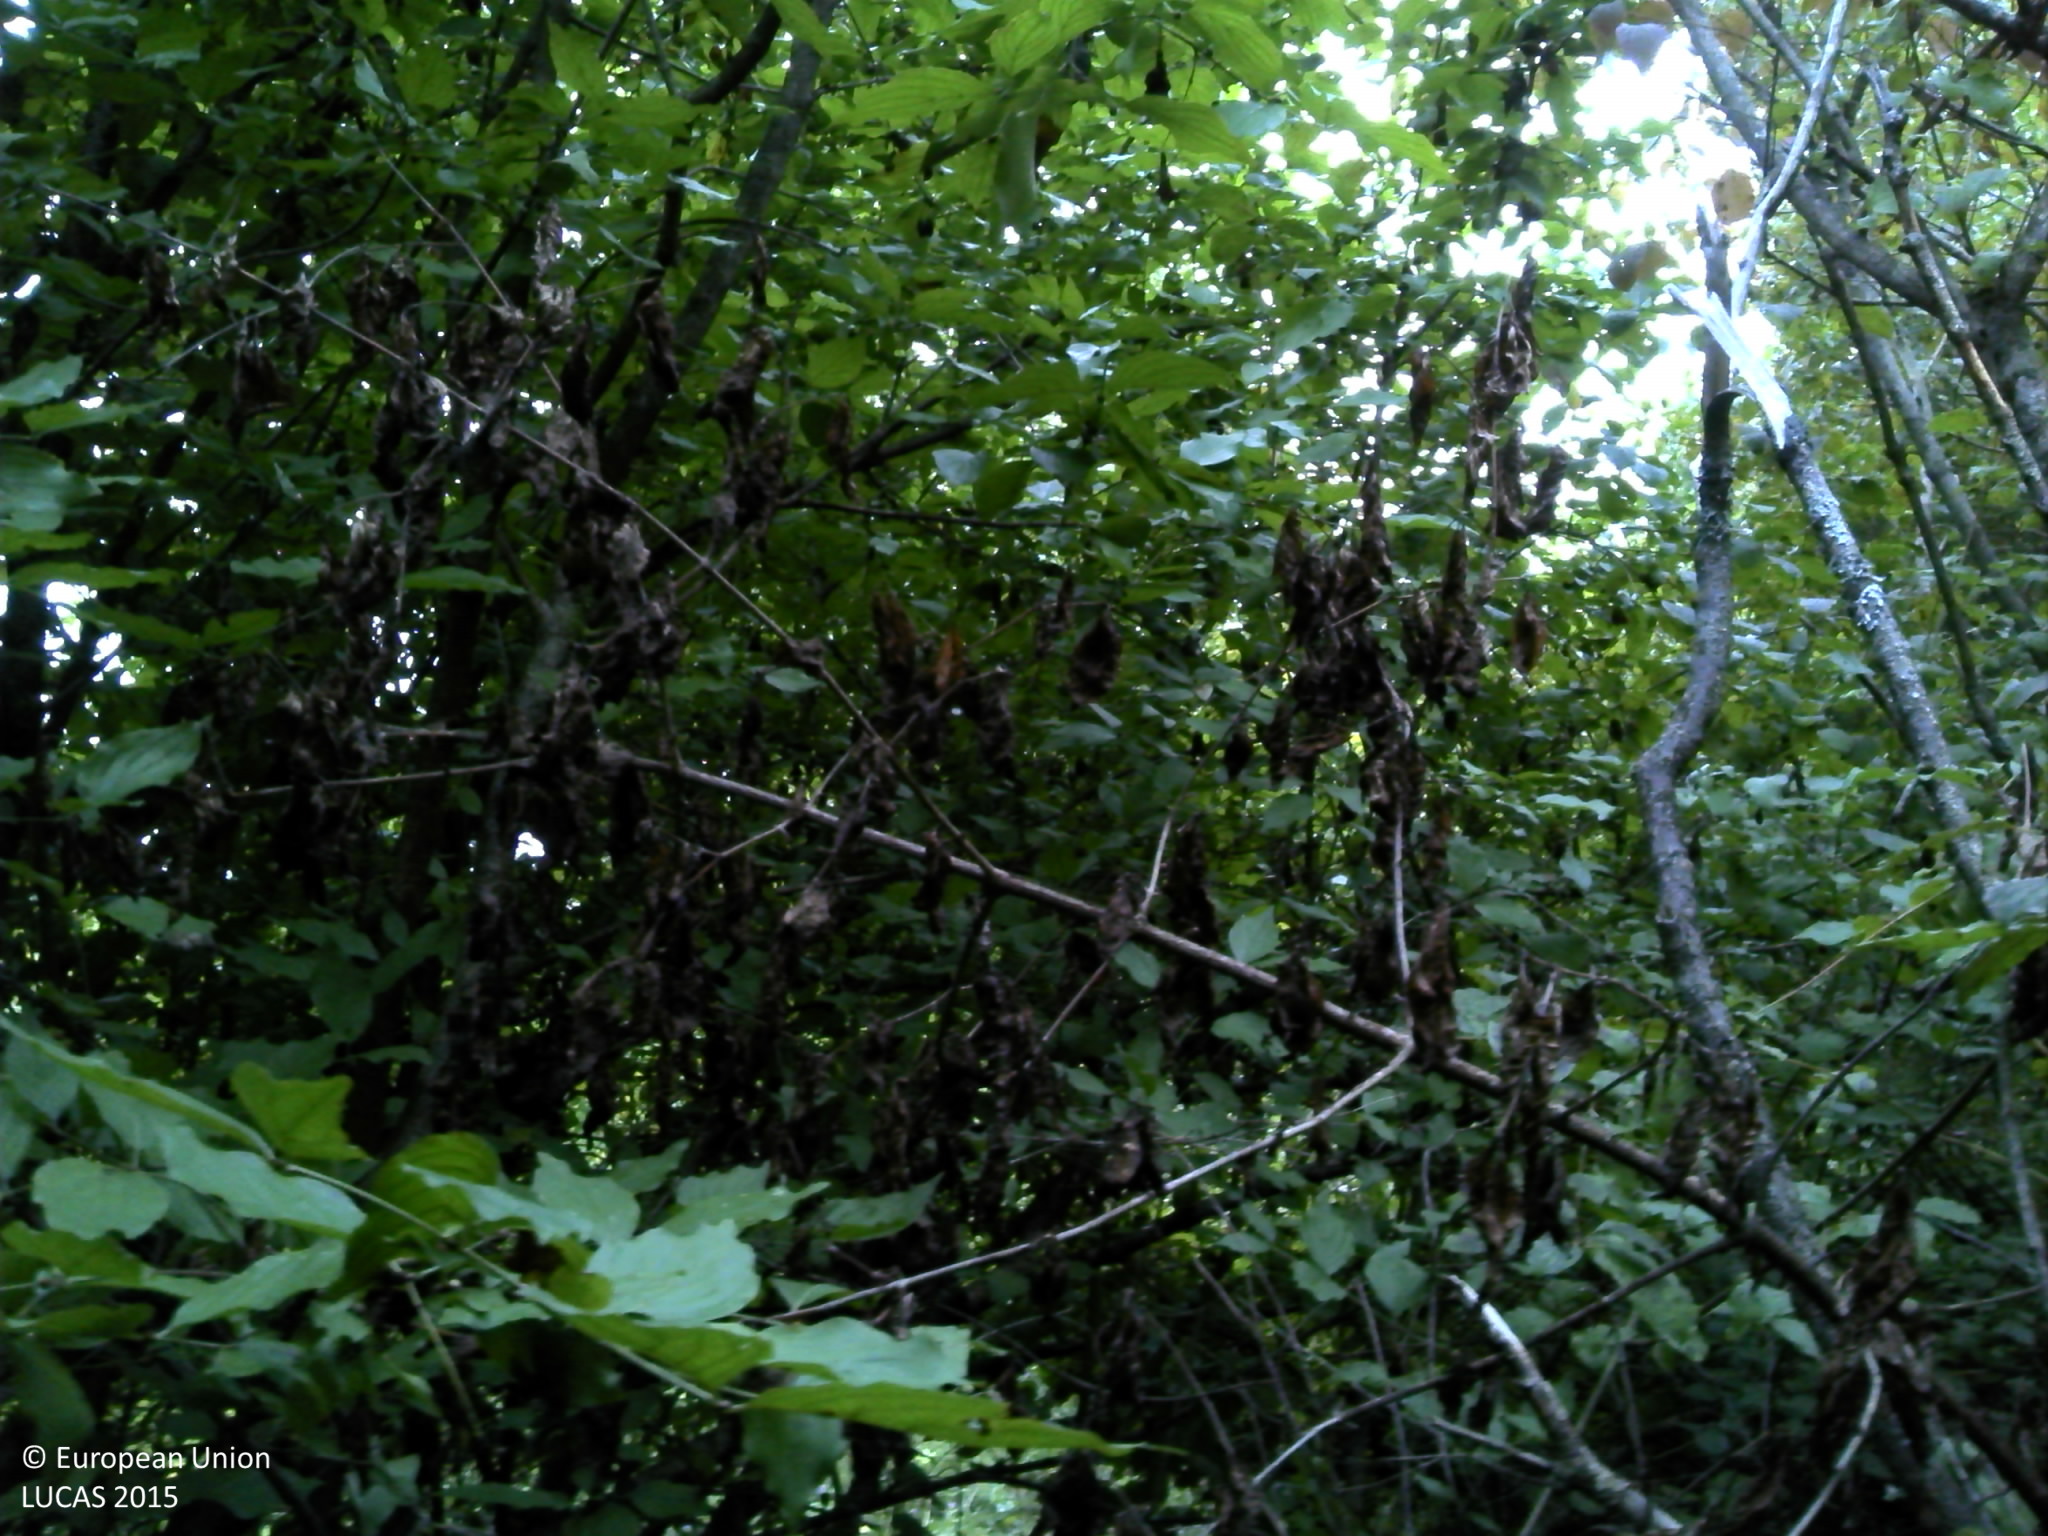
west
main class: Woodland
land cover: Broadleaved woodland
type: mesophytic deciduous forest
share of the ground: > 75 %
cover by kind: broadleaved forest trees 100 %
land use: Forestry
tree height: > 5 m
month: August
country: HR
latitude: 45.3185
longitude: 15.6216
